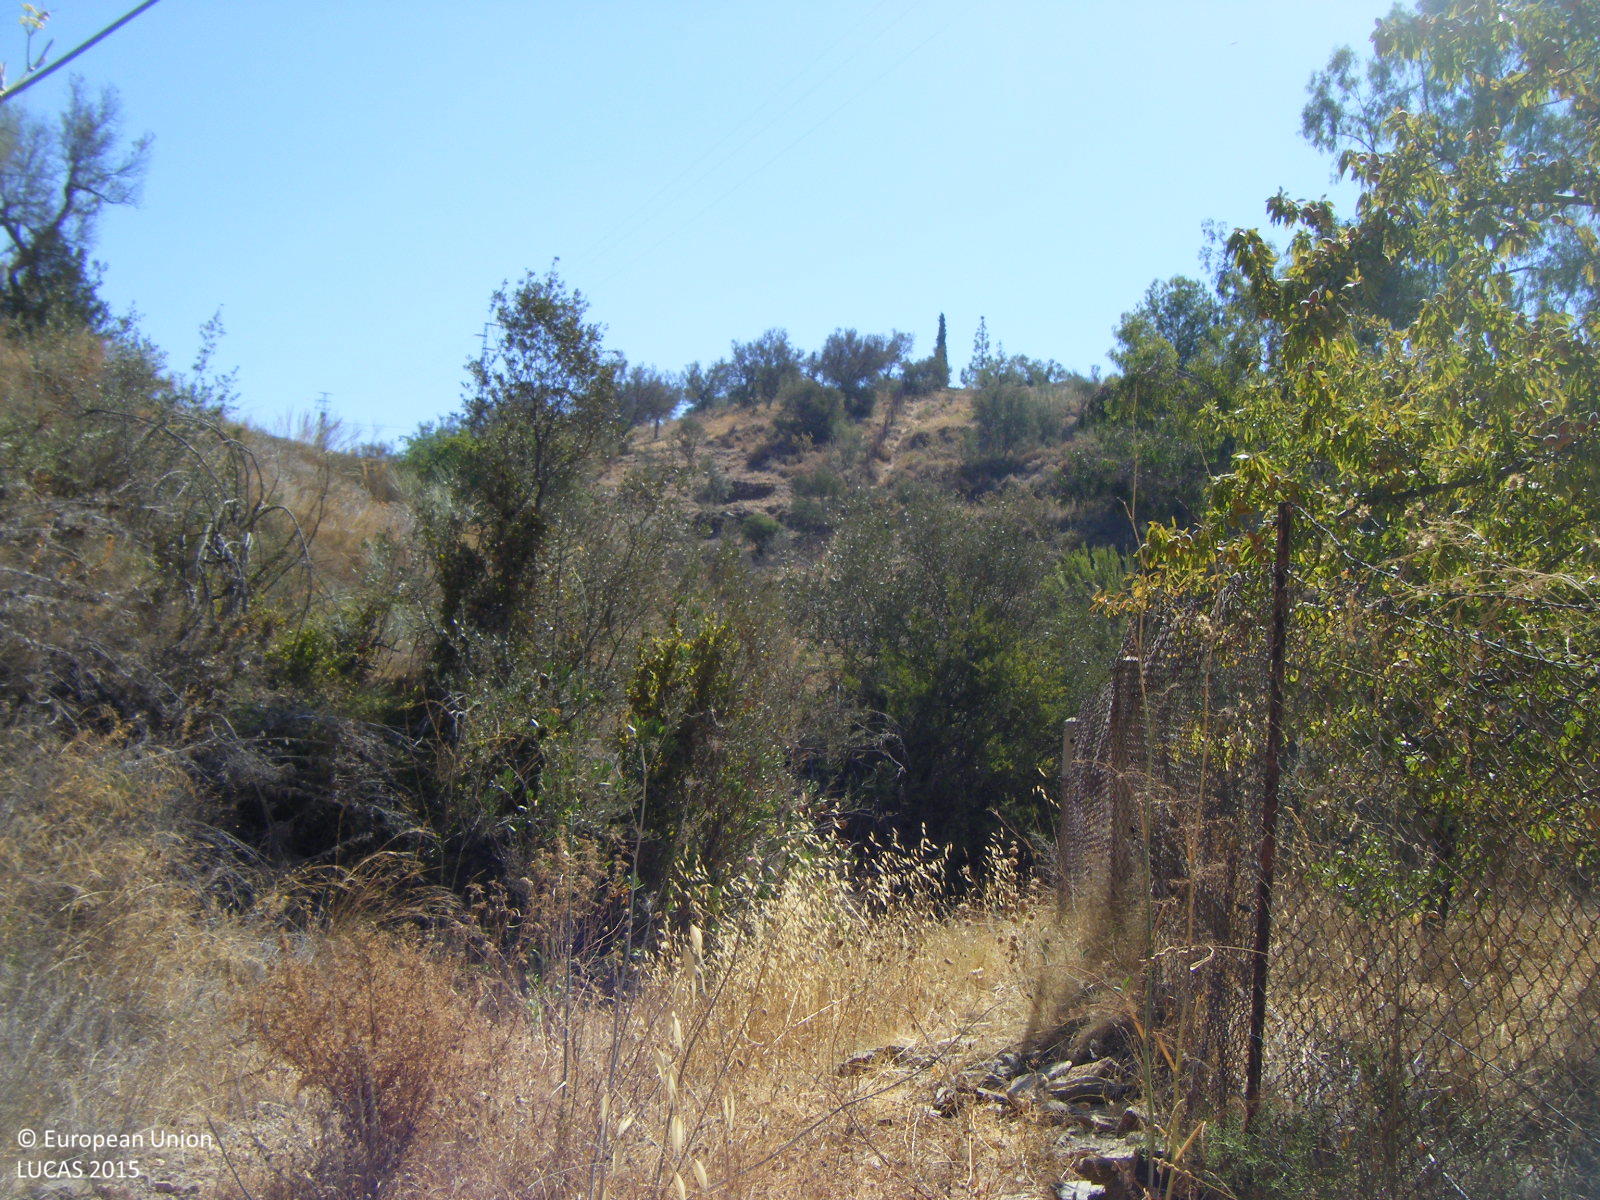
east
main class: Cropland
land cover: Olive groves
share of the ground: 10 - 25 %
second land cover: Spontaneously vegetated surfaces
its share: > 75 %
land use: Abandoned areas
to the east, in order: Olive groves; Spontaneously vegetated surfaces; Rivers and streams; Shrubland without tree cover; Olive groves; Shrubland without tree cover; Tracks; Grassland without tree/shrub cover
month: July
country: ES
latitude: 36.7326
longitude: -4.3110
